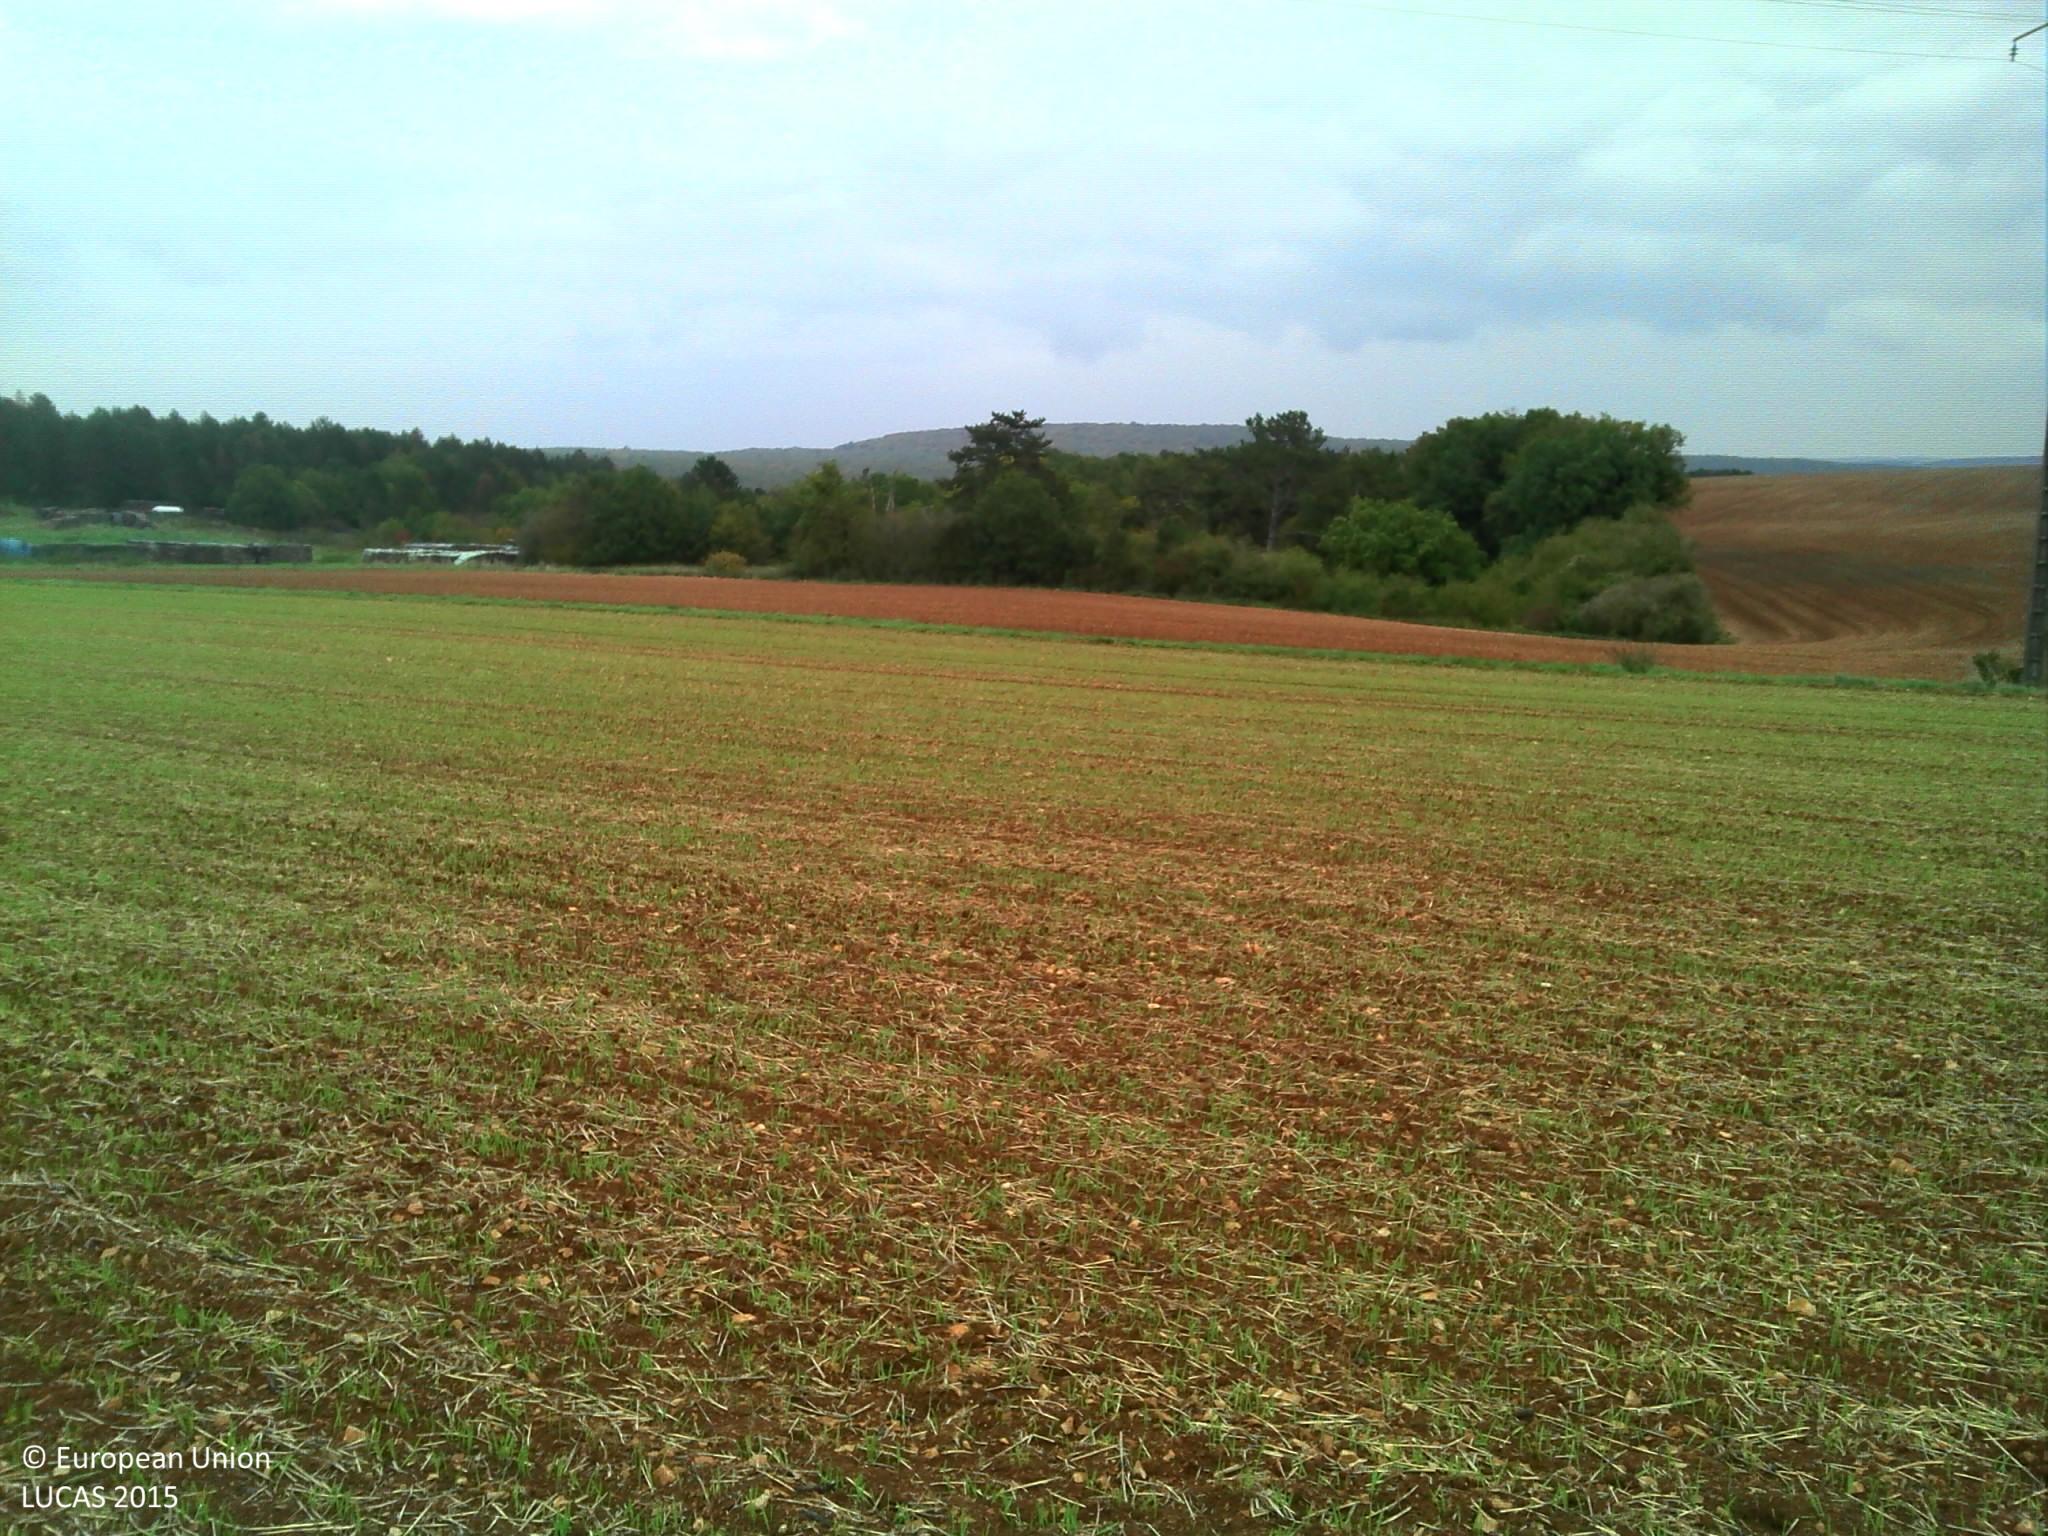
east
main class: Cropland
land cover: Common wheat
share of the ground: 10 - 25 %
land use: Agriculture (excluding fallow land and kitchen gardens)
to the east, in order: Common wheat; Electric lines; Grass margins; Tracks; Grass margins; Other bare soil; Spontaneously vegetated surfaces; Broadleaved woodland; Spontaneously vegetated surfaces
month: October
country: FR
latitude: 47.5519
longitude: 5.0169
